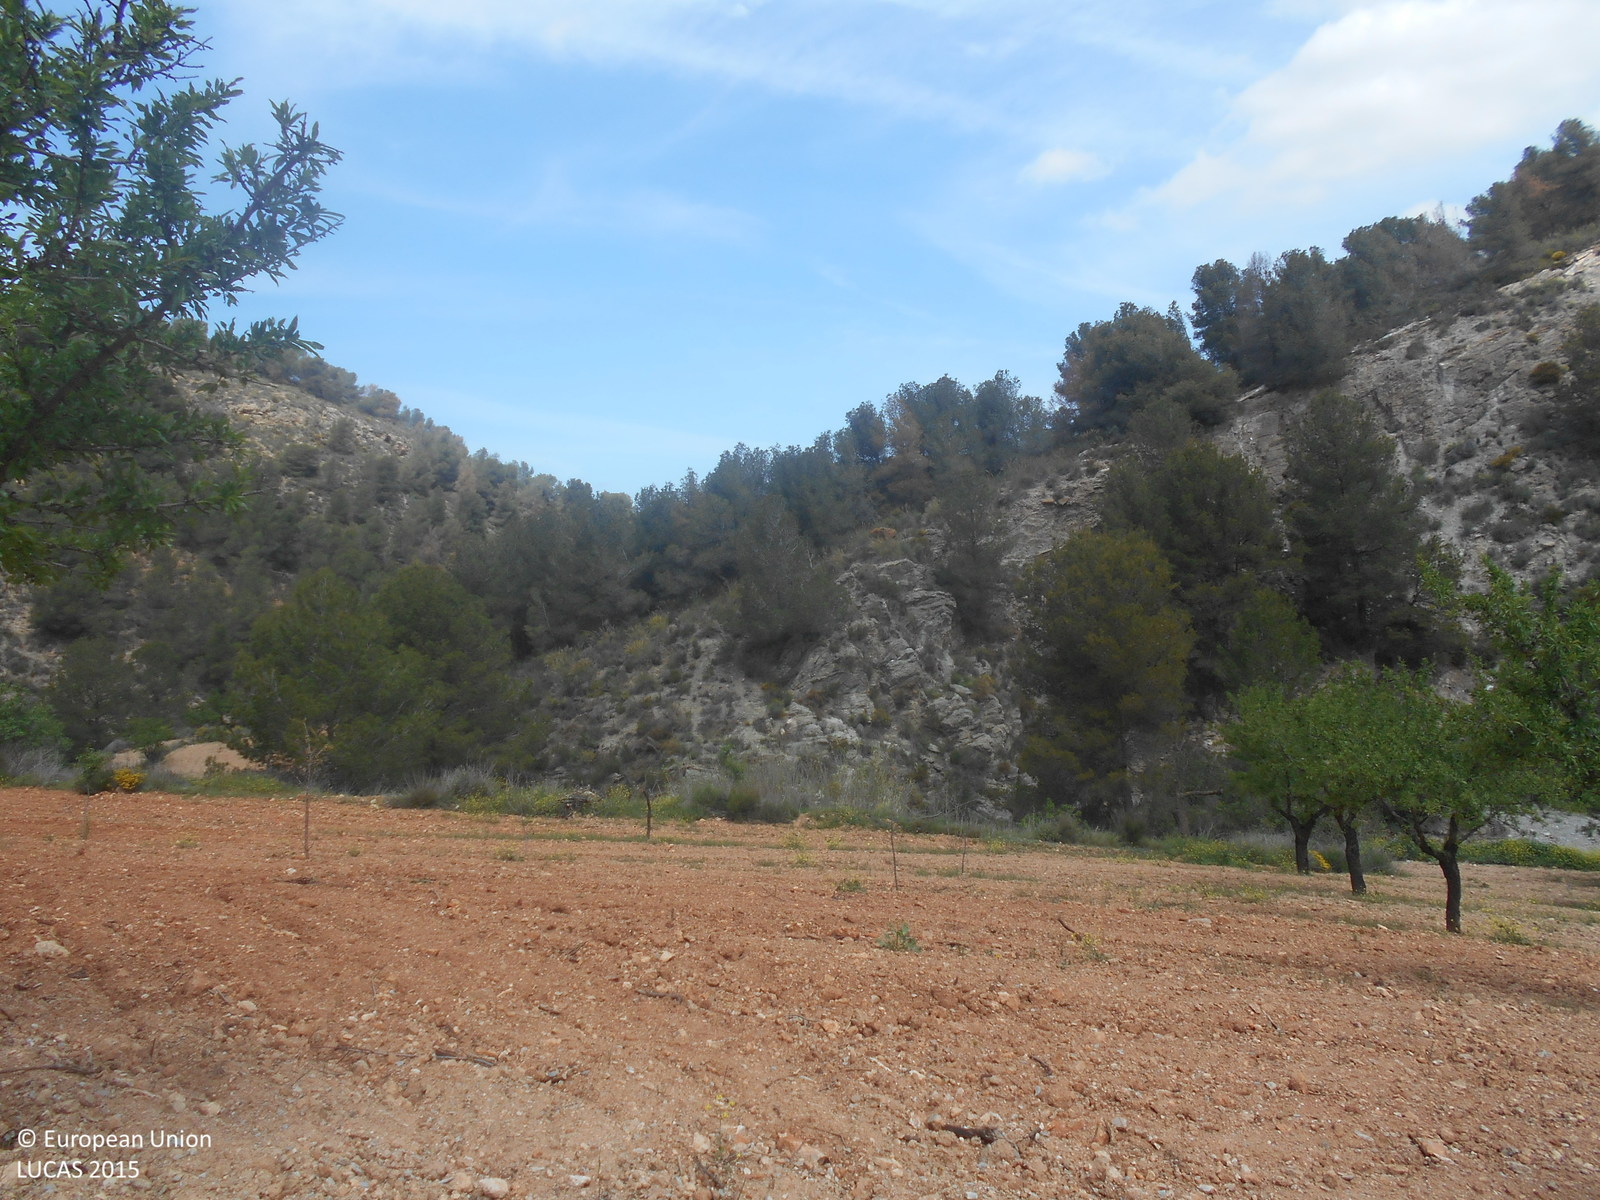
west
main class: Woodland
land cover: Pine dominated coniferous woodland
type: coniferous forest of the mediterranean region
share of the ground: > 75 %
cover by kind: coniferous forest trees 50 %, shrubs 40 %, unconsolidated bare surface 10 %
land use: Semi-natural and natural areas not in use
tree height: > 5 m
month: April
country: ES
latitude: 37.6296
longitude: -1.5276
